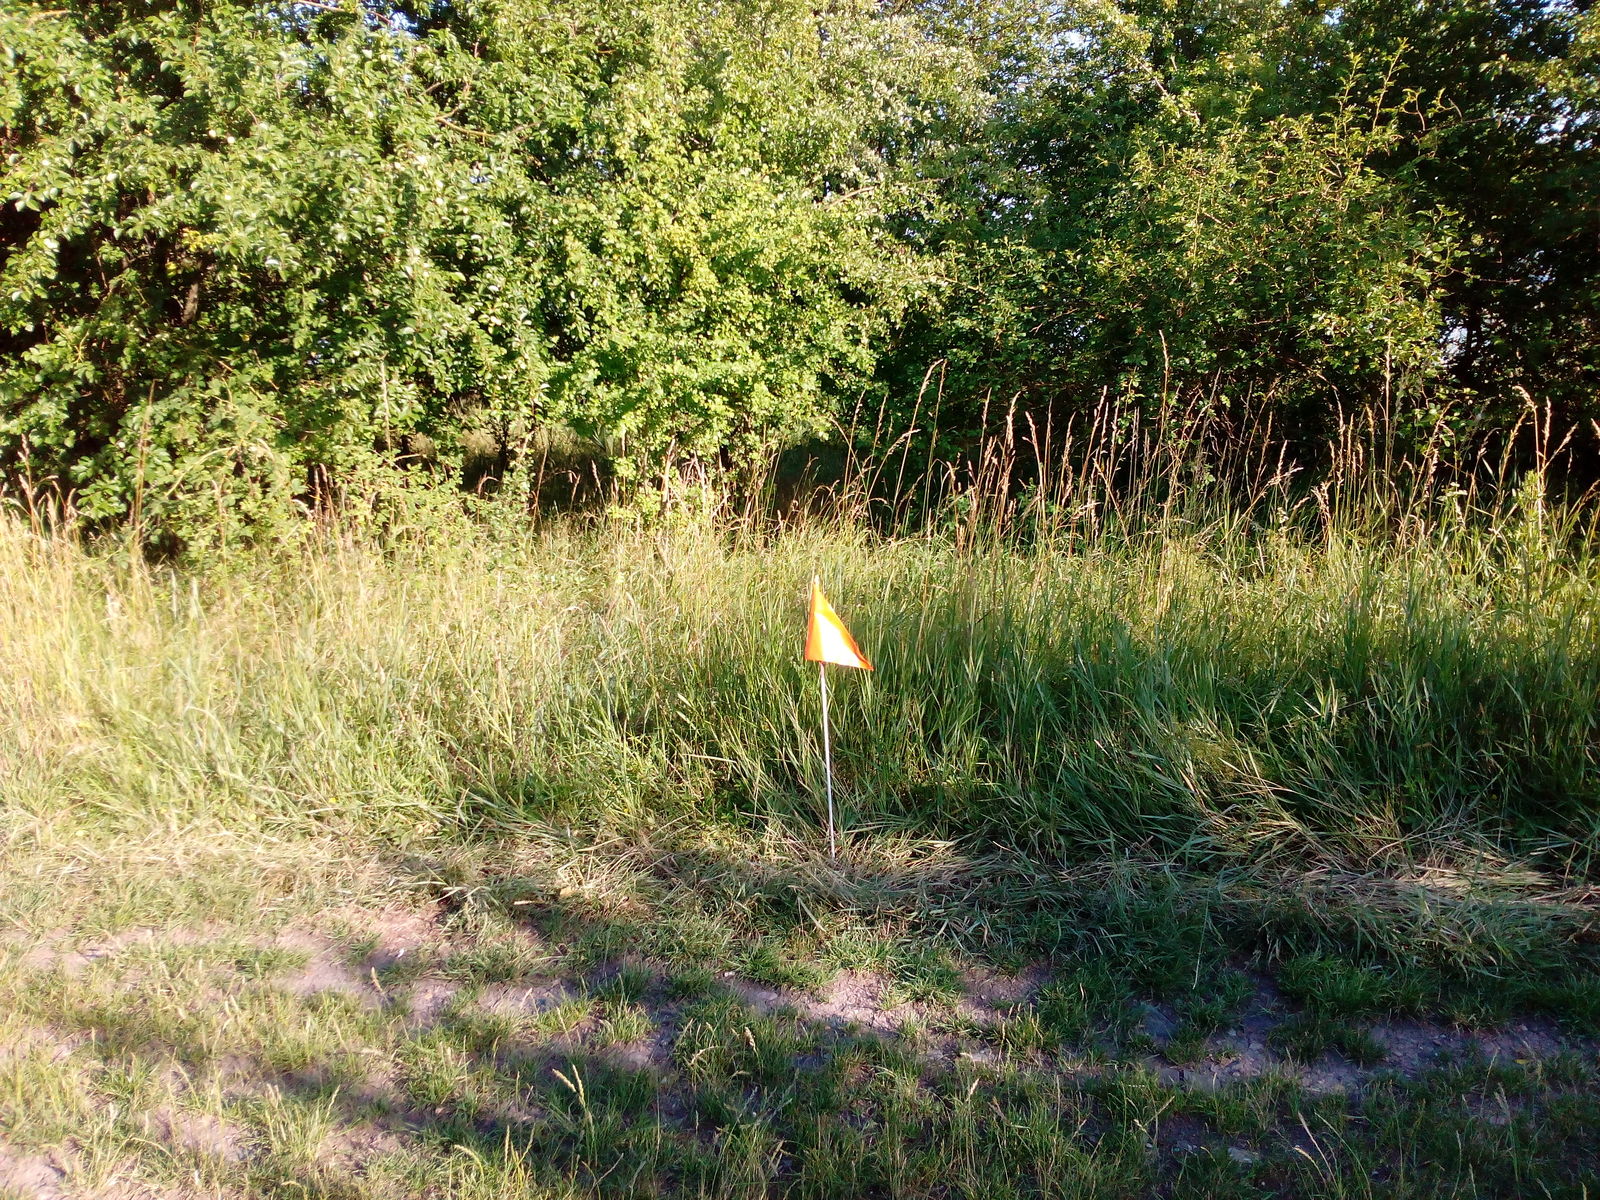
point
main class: Woodland
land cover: Broadleaved woodland
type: mesophytic deciduous forest
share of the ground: 50 - 75 %
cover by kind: broadleaved forest trees 70 %, shrubs 30 %
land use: Abandoned areas
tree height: > 5 m
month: July
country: DE
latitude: 51.1512
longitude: 10.9576
